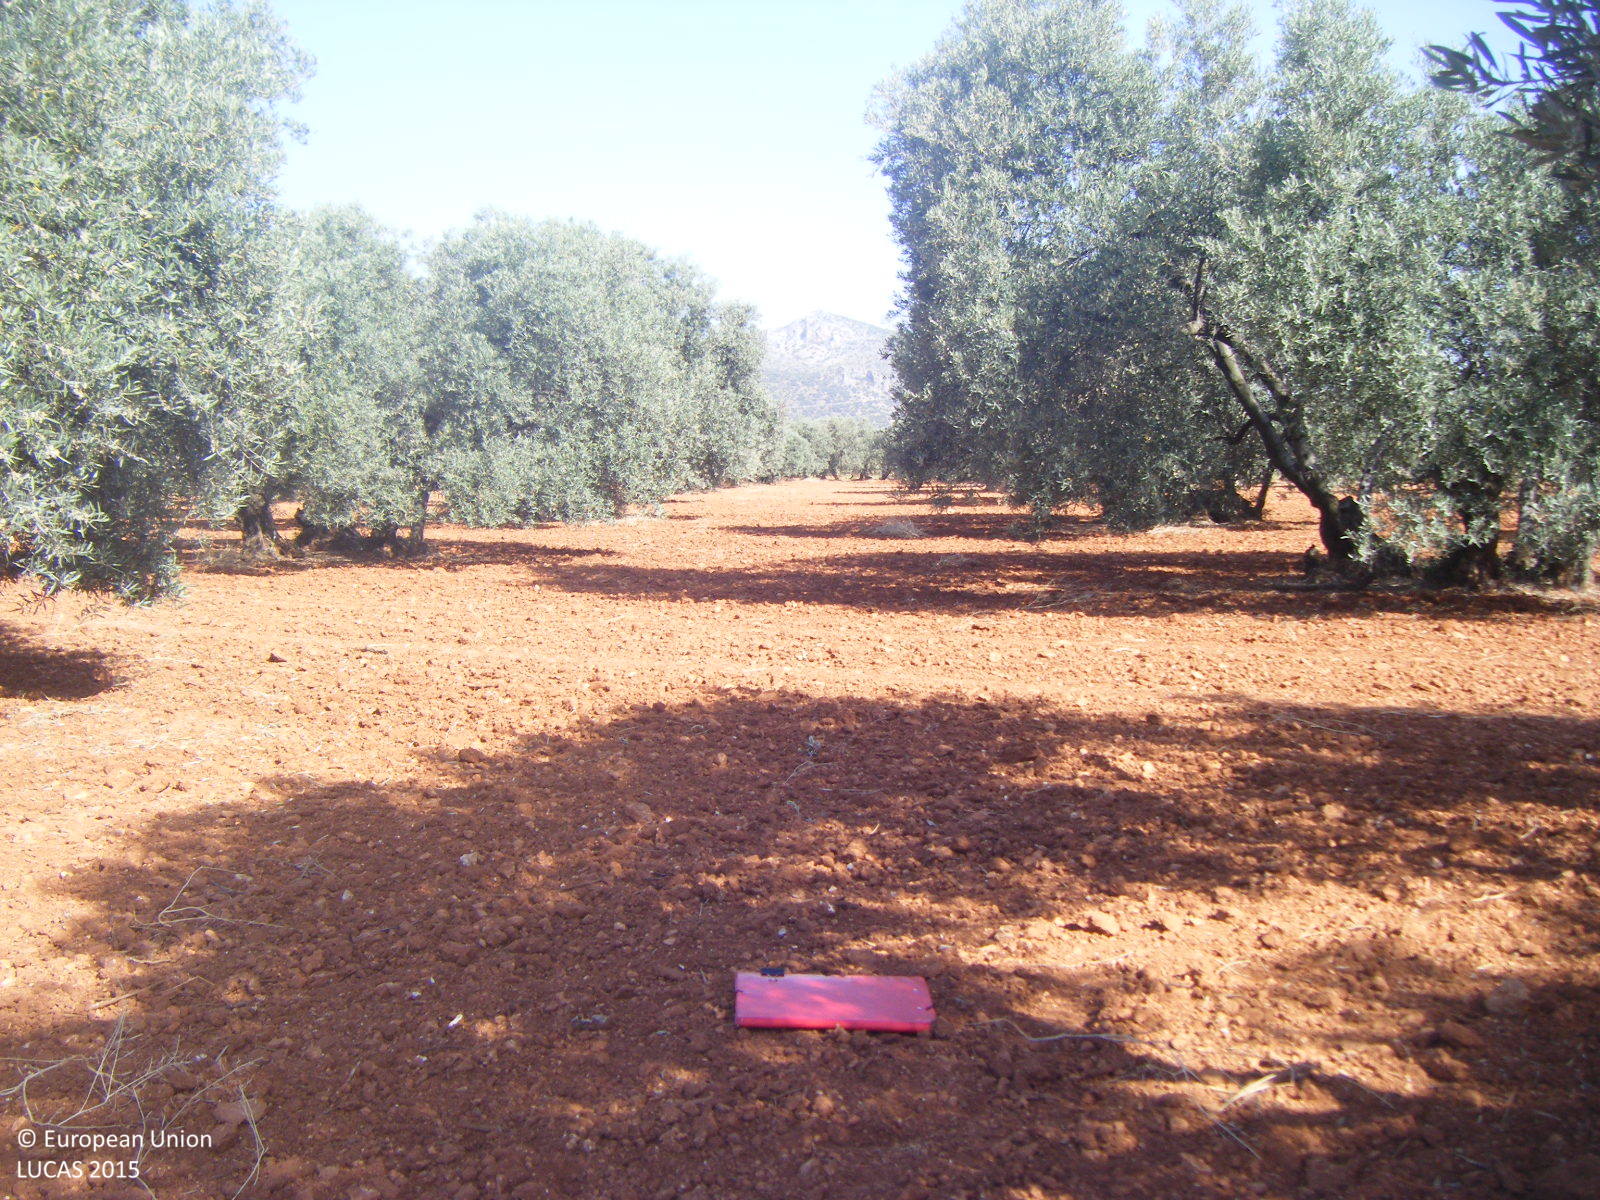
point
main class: Cropland
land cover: Olive groves
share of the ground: 25 - 50 %
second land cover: Other bare soil
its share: > 75 %
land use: Agriculture (excluding fallow land and kitchen gardens)
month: May
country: ES
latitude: 37.2298
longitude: -4.7794
